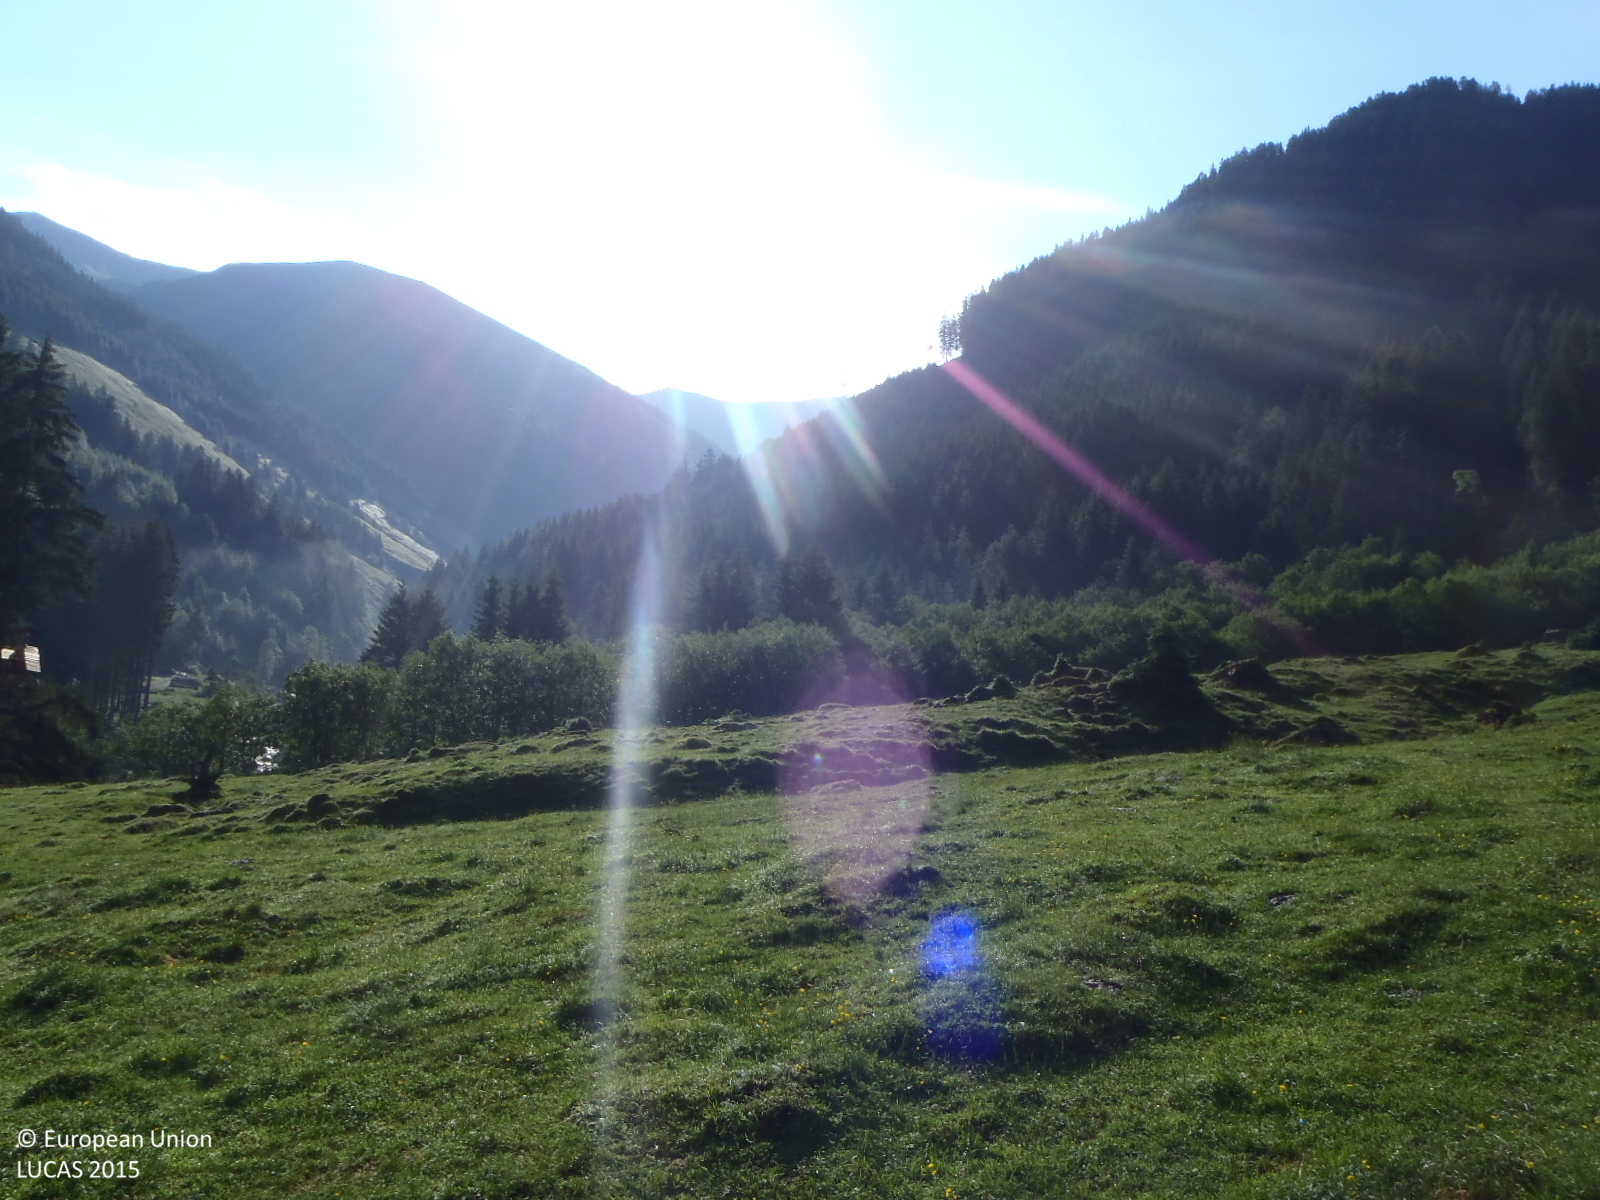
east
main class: Grassland
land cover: Grassland without tree/shrub cover
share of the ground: > 75 %
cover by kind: herbaceous plants 100 %
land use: Agriculture (excluding fallow land and kitchen gardens)
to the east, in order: Grassland without tree/shrub cover; Tracks; Grassland without tree/shrub cover; Broadleaved woodland; Rivers and streams; Spruce dominated mixed woodland; Rivers and streams; Broadleaved woodland; Grassland without tree/shrub cover; Broadleaved woodland; Rivers and streams; Broadleaved woodland; Spruce dominated mixed woodland; Fences; Spruce dominated coniferous woodland; Rivers and streams; Spruce dominated coniferous woodland
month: June
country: AT
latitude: 47.1959
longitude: 12.8622
